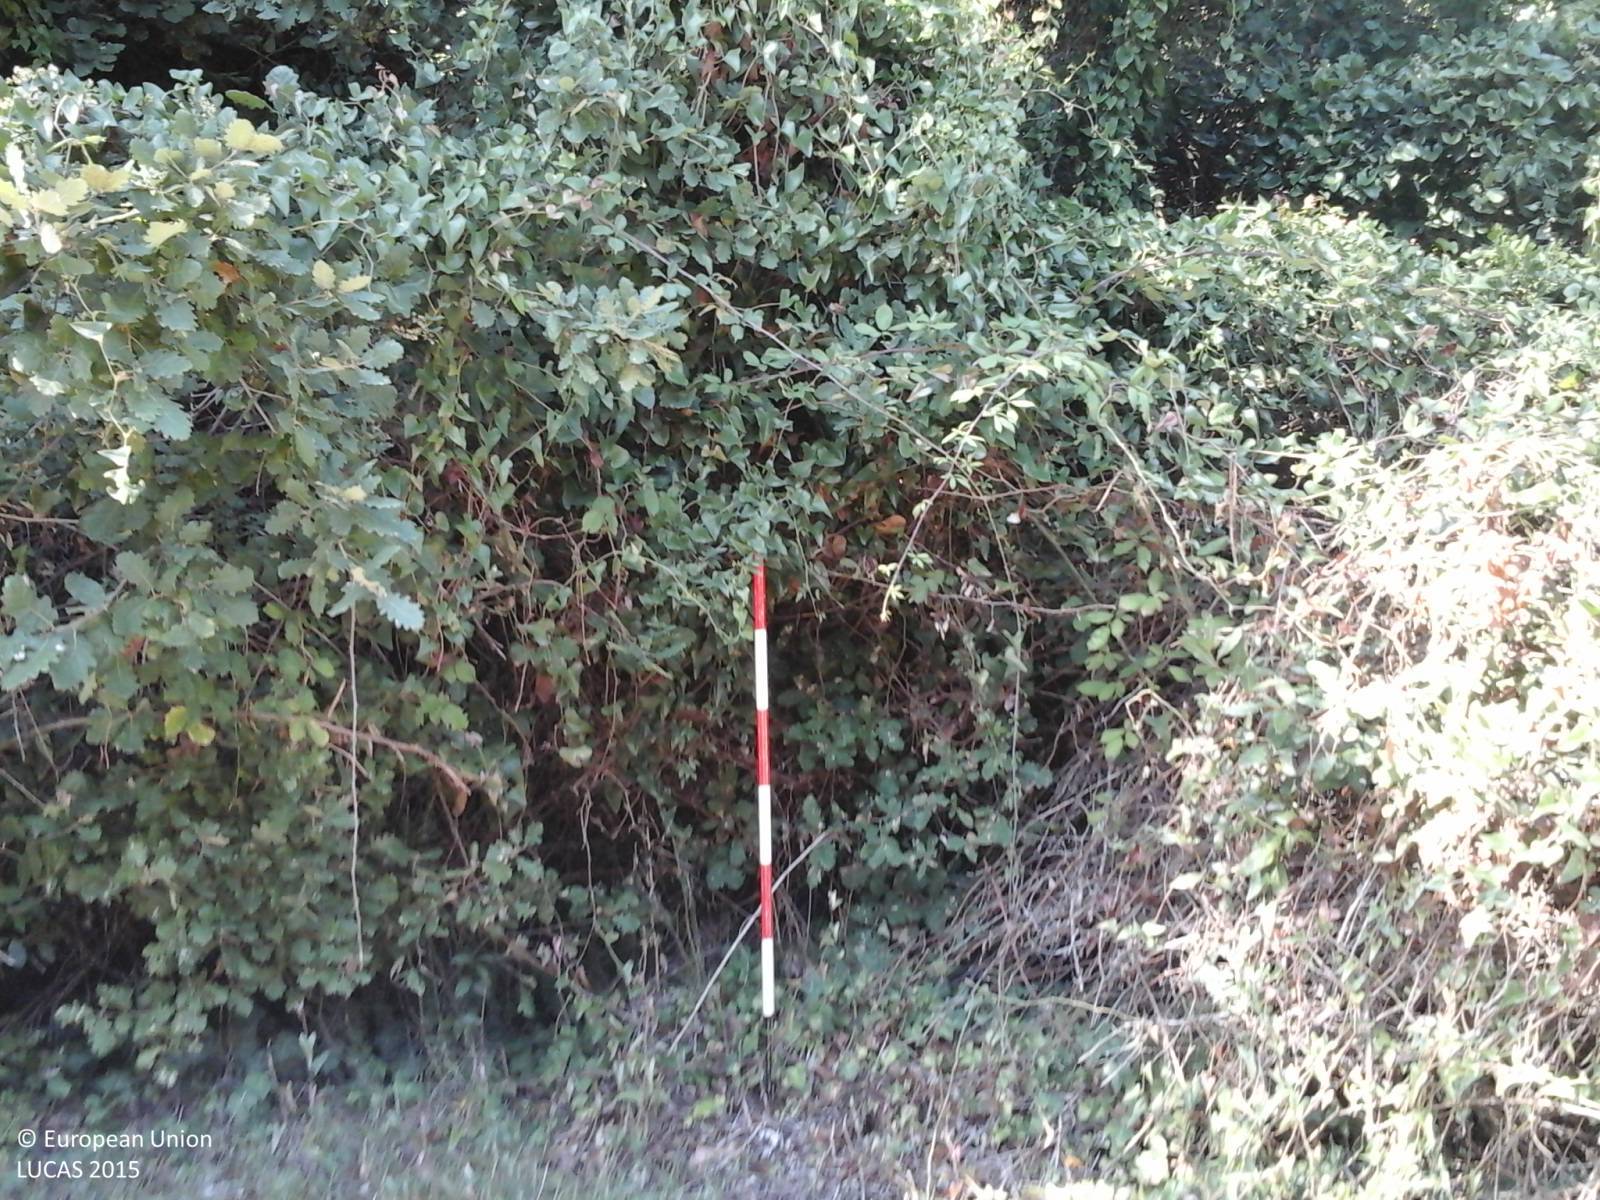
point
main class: Woodland
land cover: Broadleaved woodland
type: broadleaved evergreen forest
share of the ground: > 75 %
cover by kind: broadleaved forest trees 90 %, shrubs 10 %
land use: Semi-natural and natural areas not in use
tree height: > 5 m
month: October
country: IT
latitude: 40.2028
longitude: 8.5859
